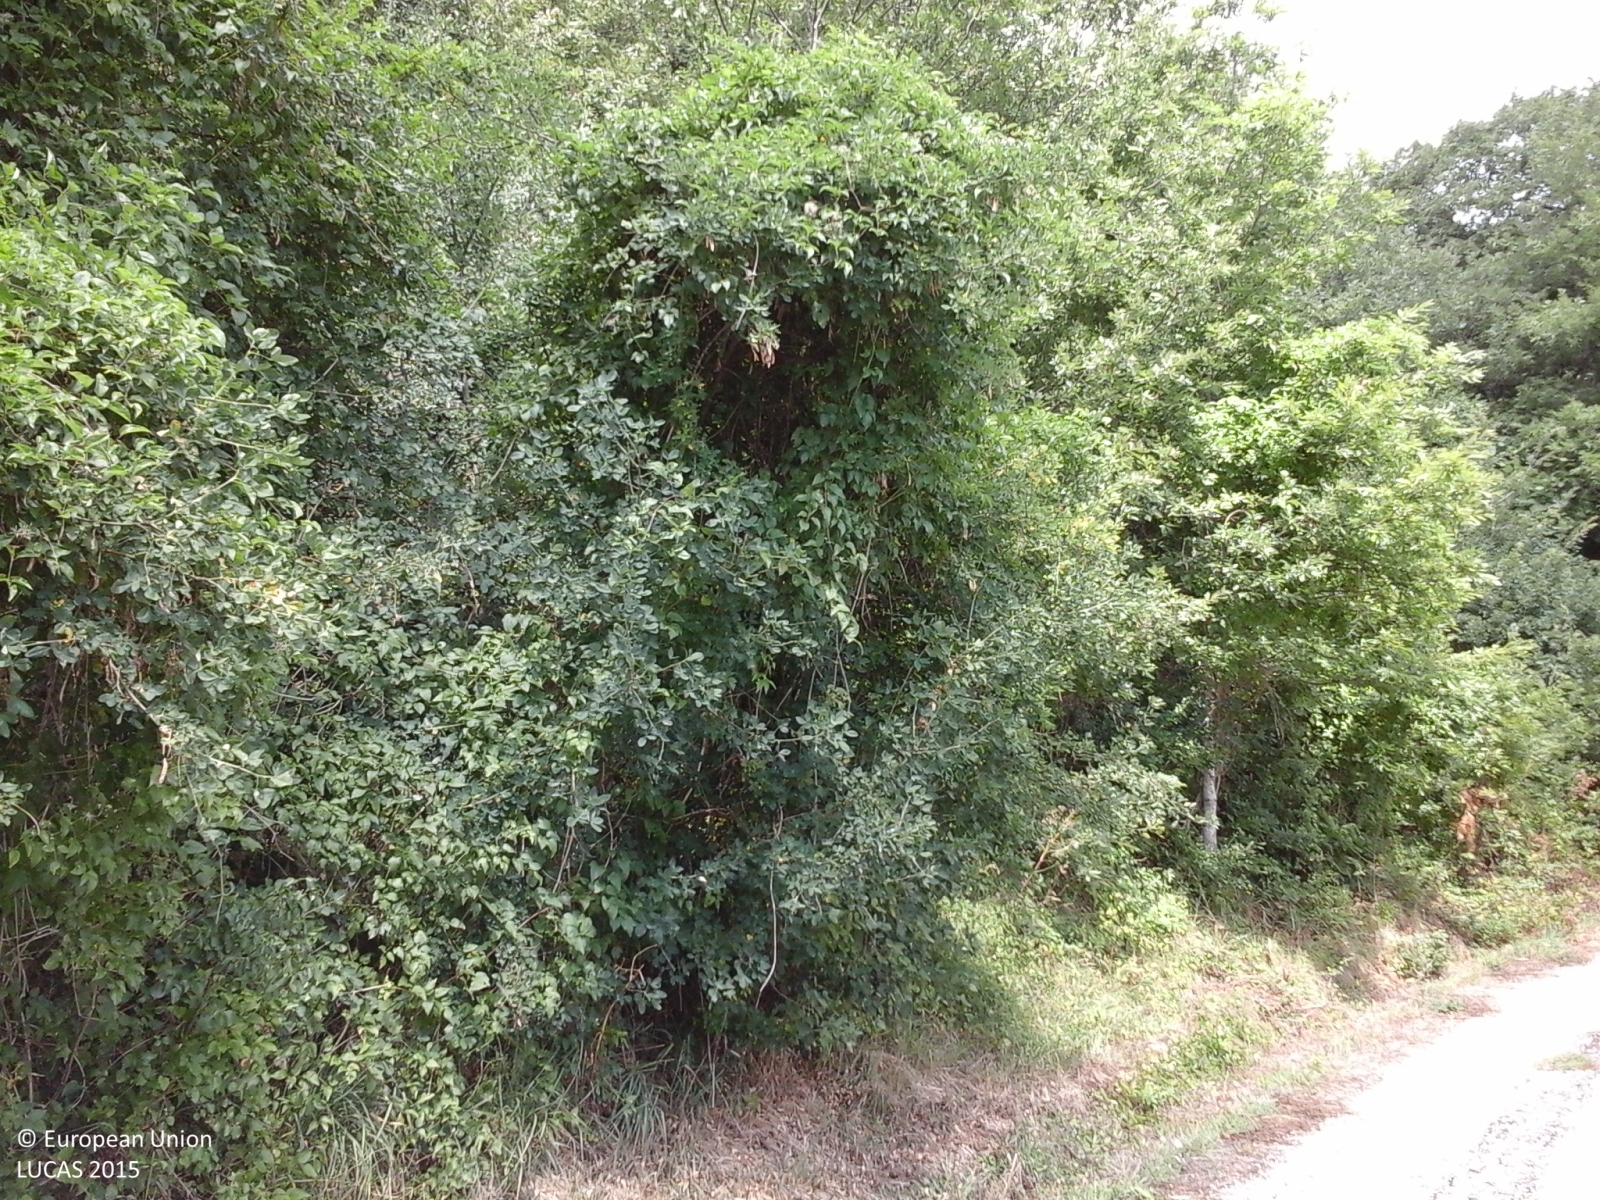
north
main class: Woodland
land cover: Broadleaved woodland
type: thermophilous deciduous forest
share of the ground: > 75 %
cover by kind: broadleaved forest trees 75 %, shrubs 15 %, herbaceous plants 10 %
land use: Semi-natural and natural areas not in use
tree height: > 5 m
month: August
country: IT
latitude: 41.7867
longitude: 14.2570
